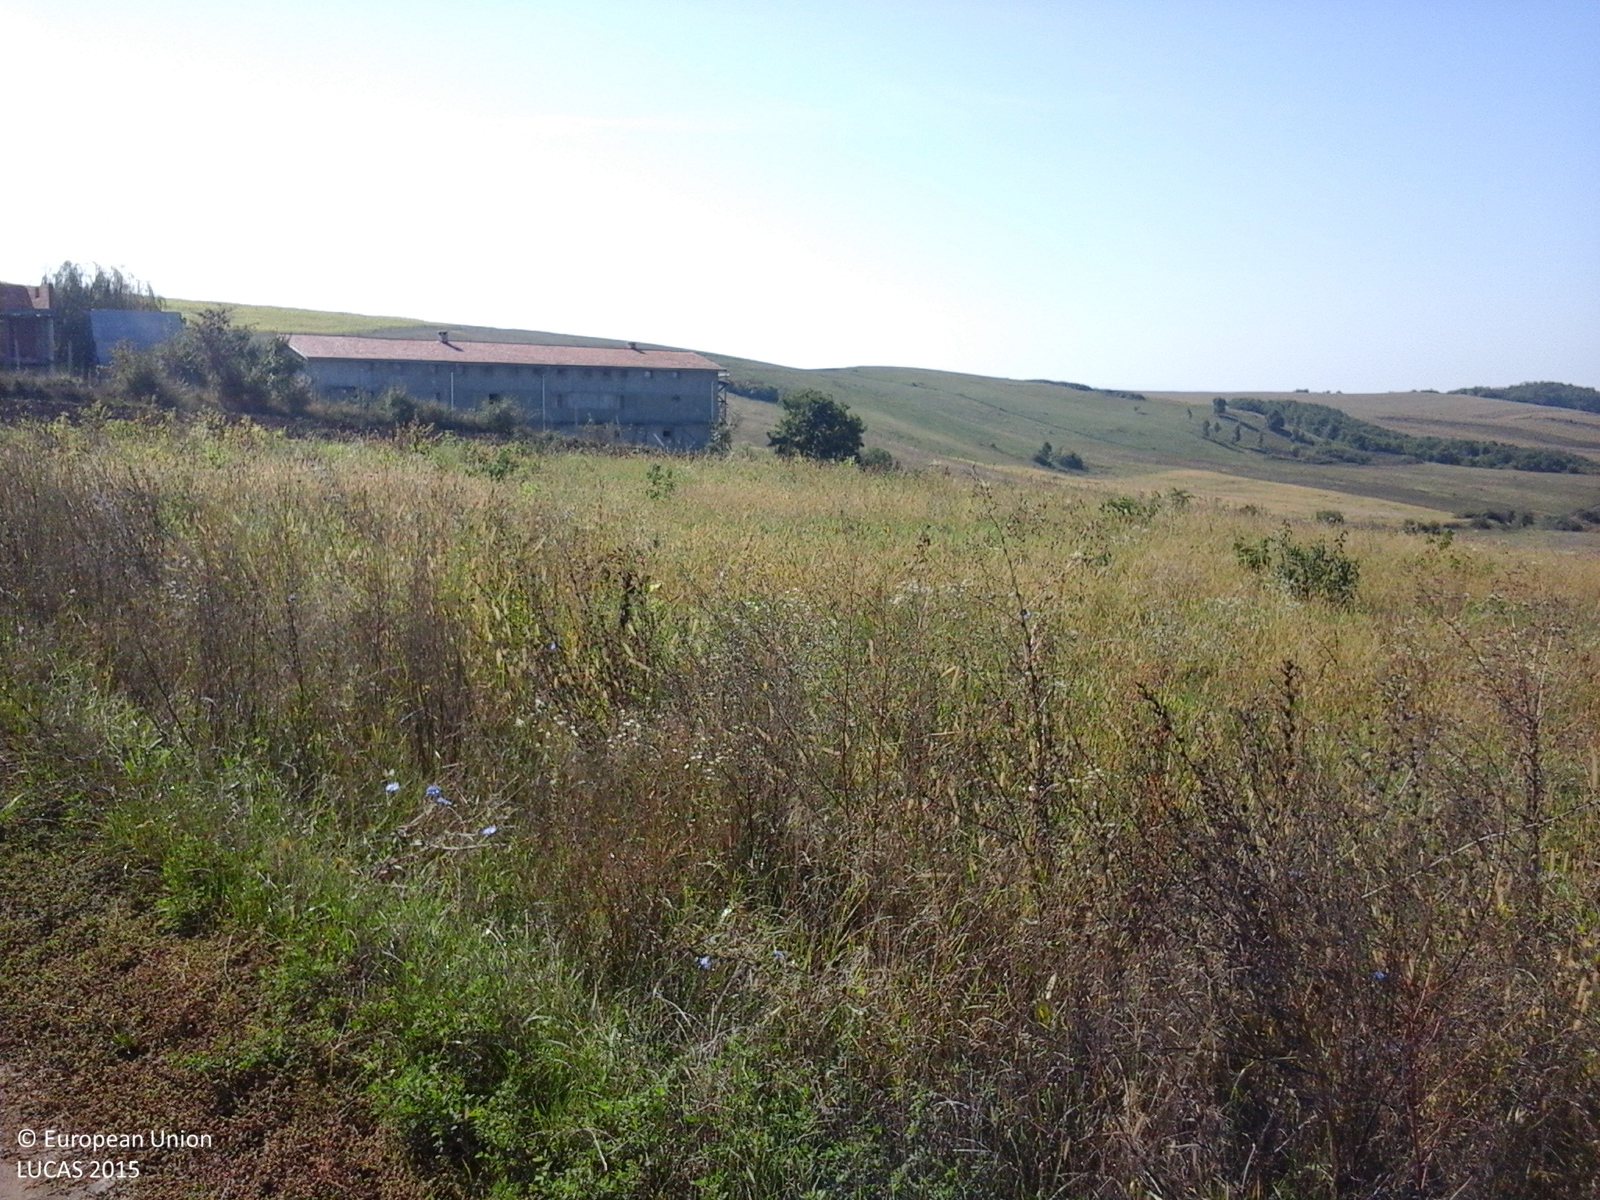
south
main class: Cropland
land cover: Maize
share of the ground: > 75 %
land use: Agriculture (excluding fallow land and kitchen gardens)
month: October
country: RO
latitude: 46.0993
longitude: 23.8741
